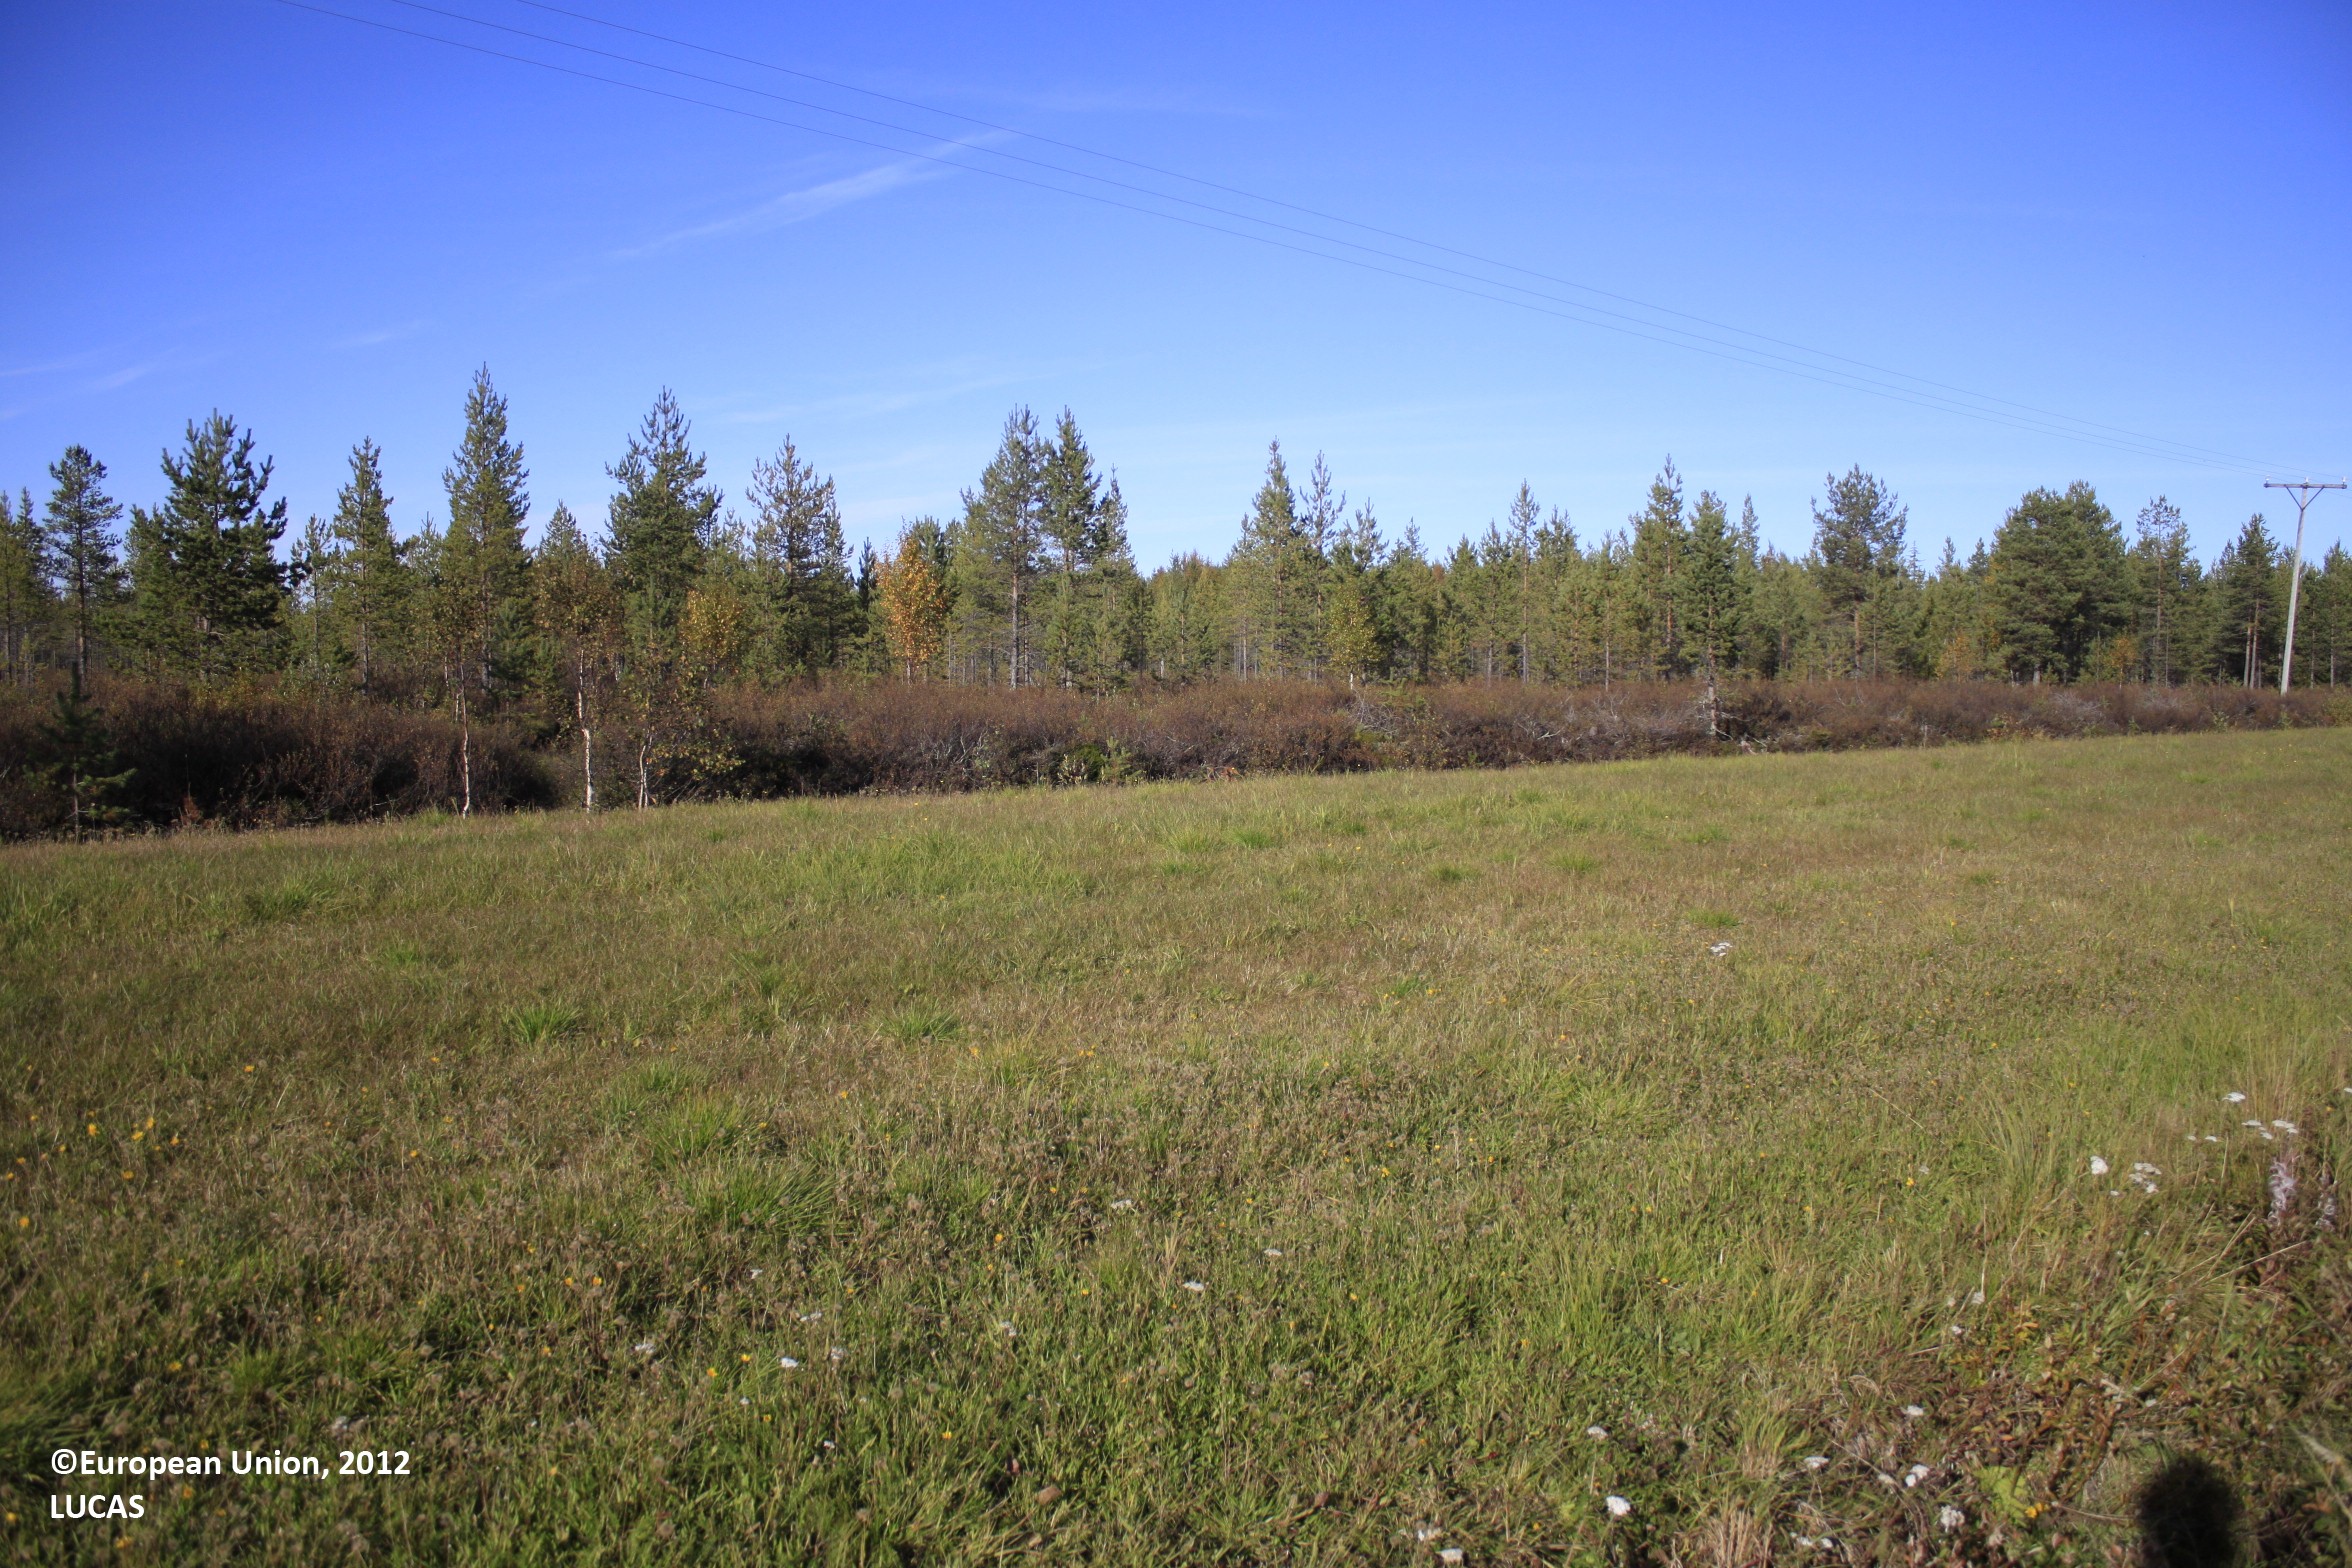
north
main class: Grassland
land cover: Grassland without tree/shrub cover
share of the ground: > 75 %
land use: Fallow land
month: September
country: FI
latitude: 65.8548
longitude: 26.7763
